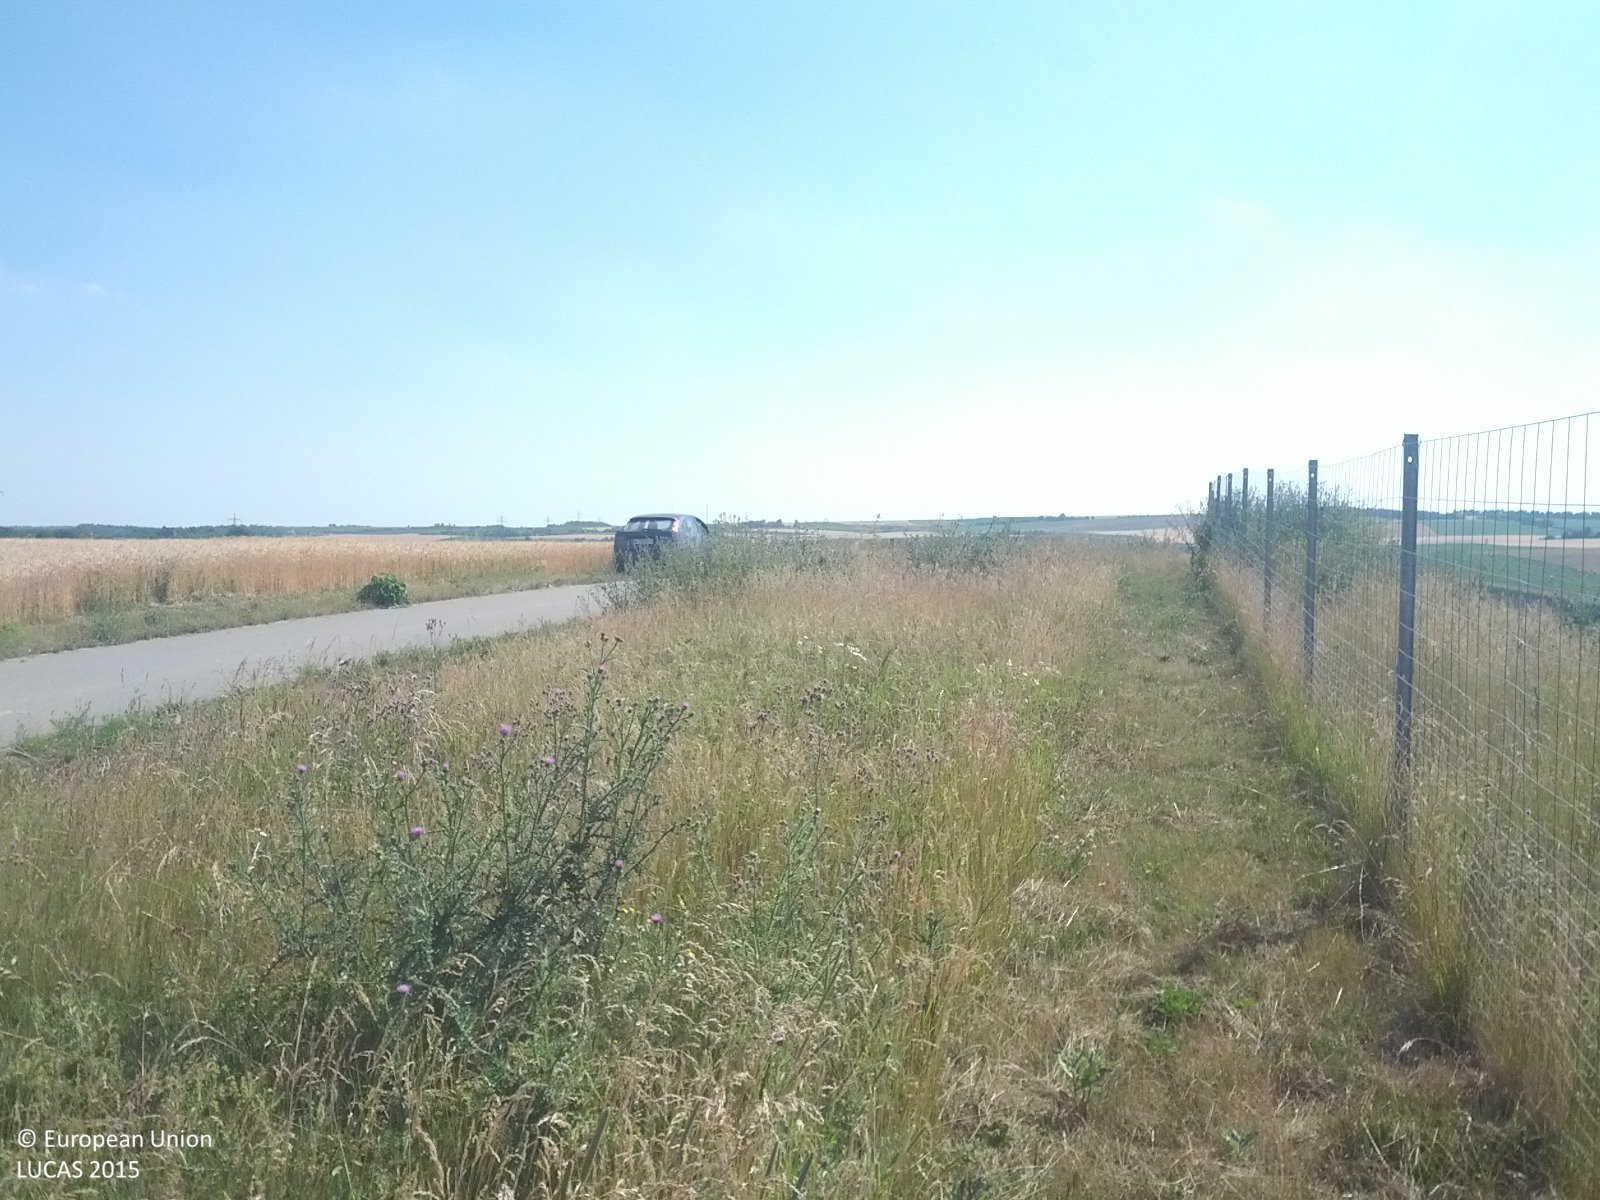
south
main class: Grassland
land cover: Grassland without tree/shrub cover
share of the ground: > 75 %
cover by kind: herbaceous plants 100 %
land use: Road transport
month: July
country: AT
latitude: 48.4790
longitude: 16.5674
